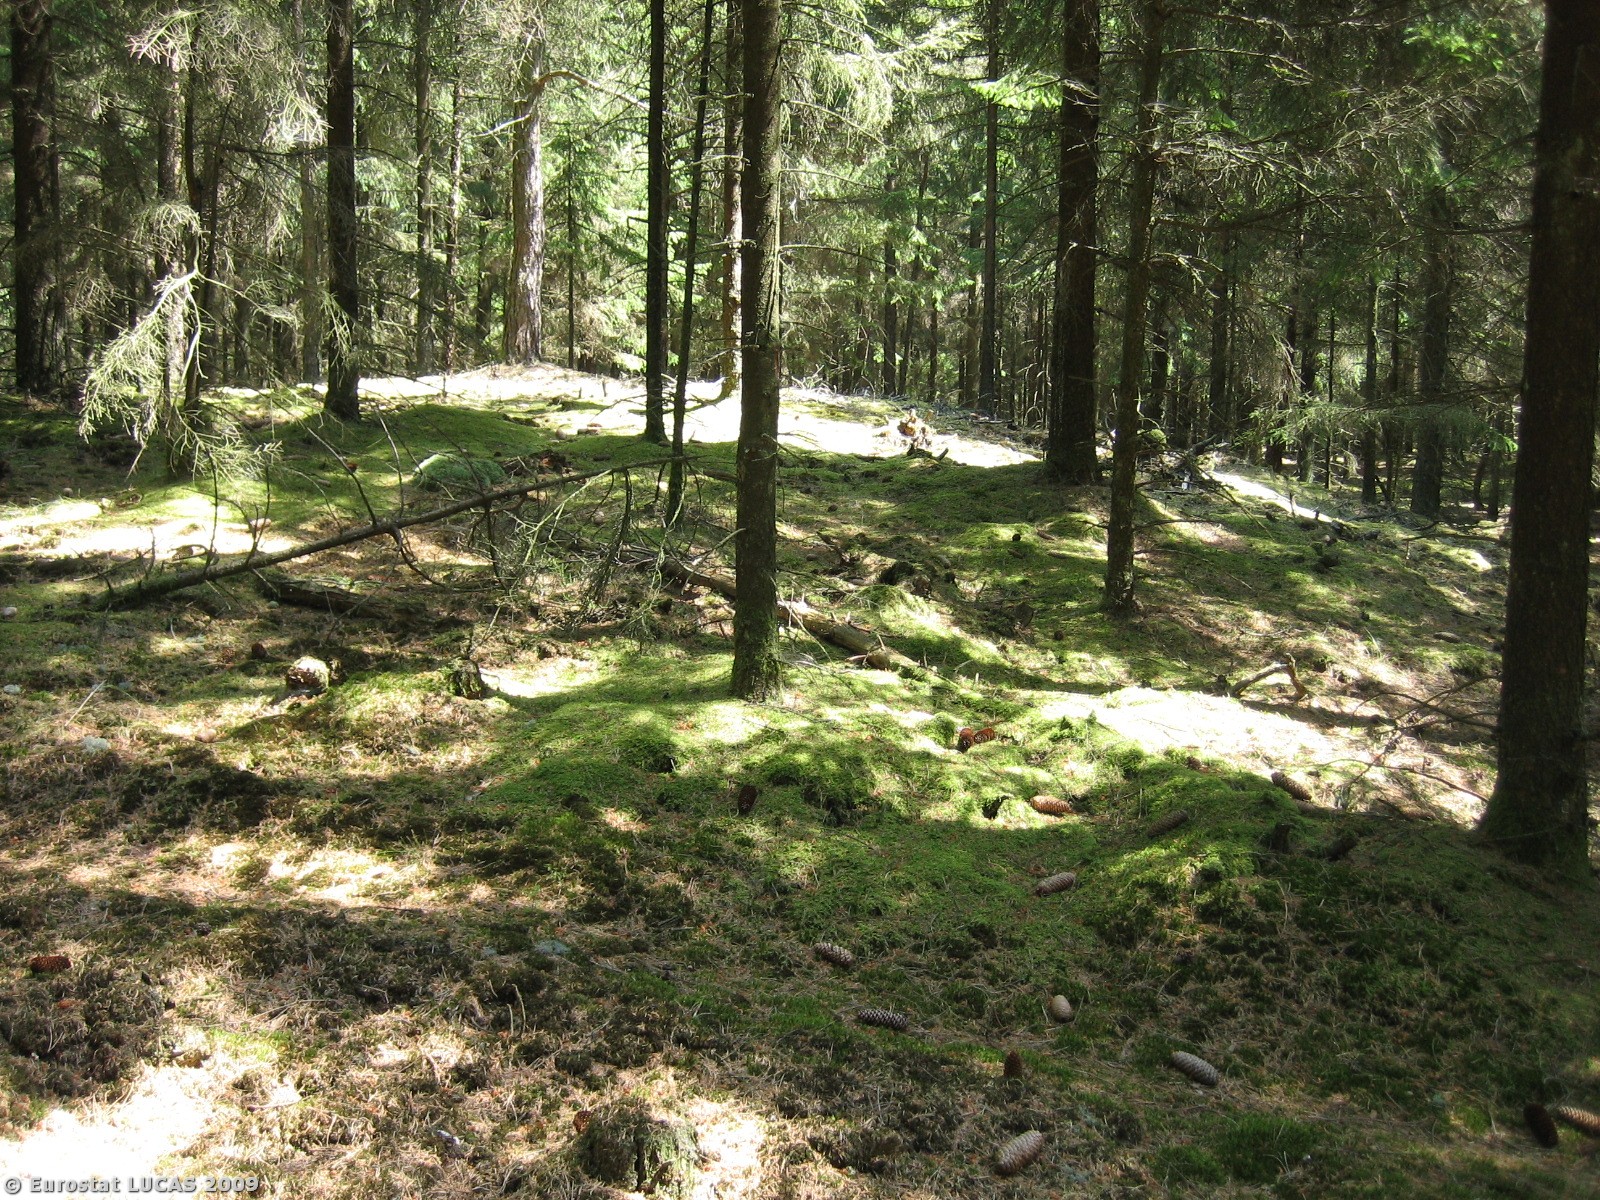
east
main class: Woodland
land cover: Coniferous woodland
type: hemiboreal forest and nemoral coniferous forest and mixed broadleaved-coniferous forest
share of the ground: > 75 %
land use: Forestry
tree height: > 5 m
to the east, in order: Coniferous woodland; Tracks; Coniferous woodland; Tracks; Coniferous woodland; Grassland with sparse tree/shrub cover
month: July
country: DK
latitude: 55.6266
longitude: 9.0004
